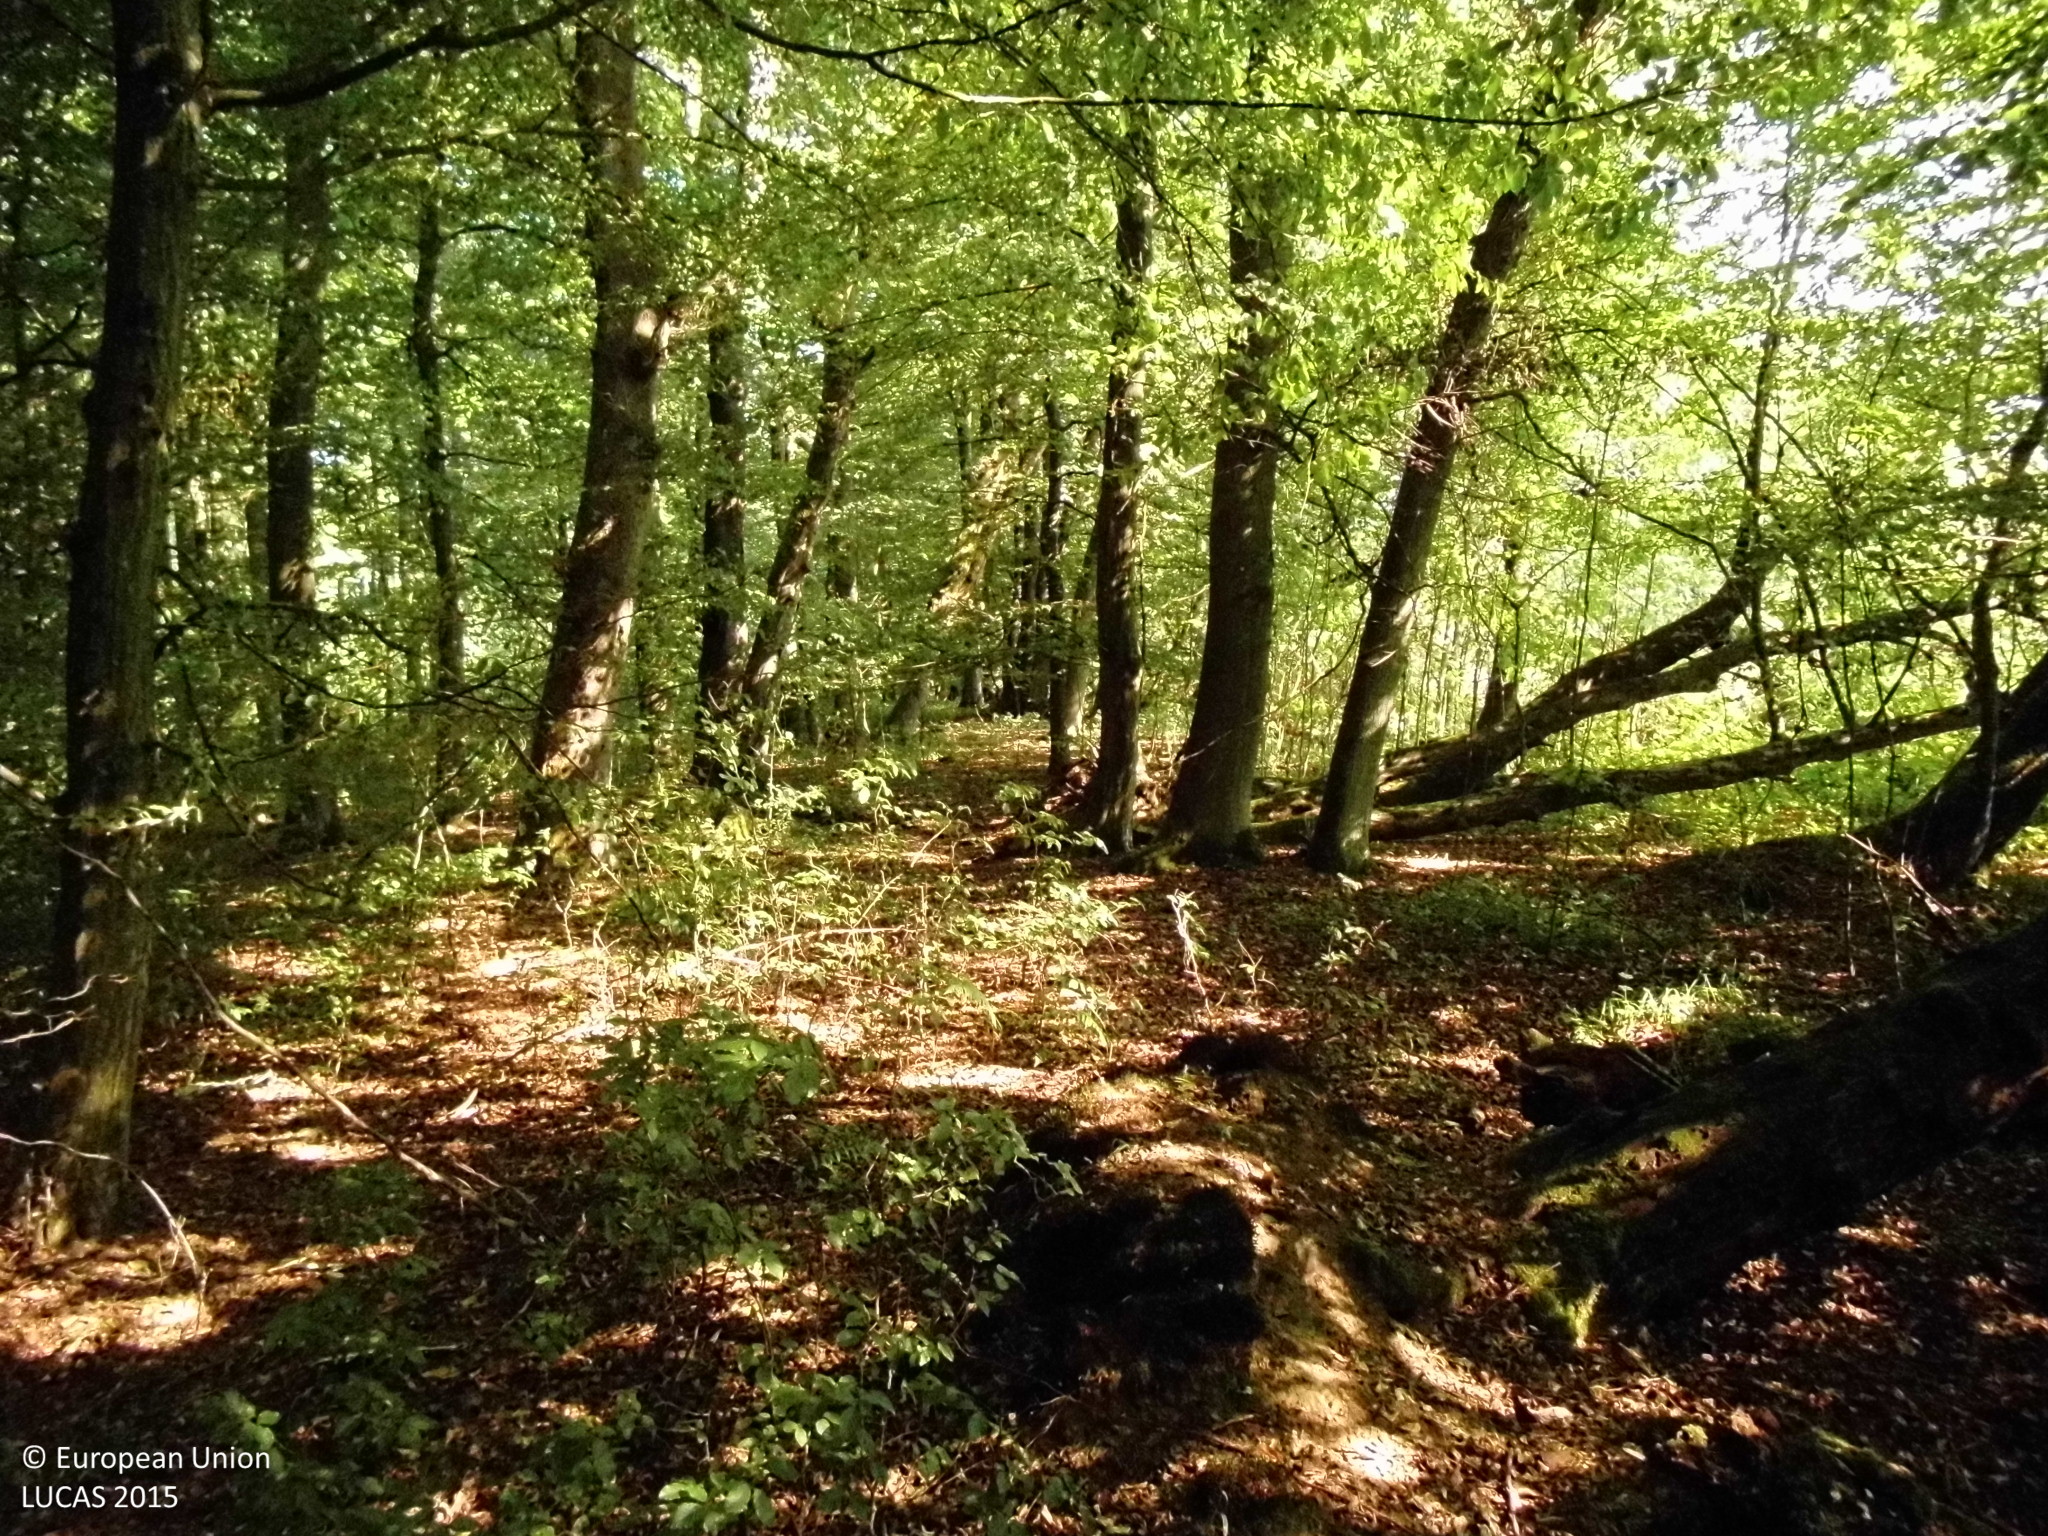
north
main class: Woodland
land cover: Broadleaved woodland
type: mesophytic deciduous forest
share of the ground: > 75 %
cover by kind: broadleaved forest trees 100 %
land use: Forestry
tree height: > 5 m
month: August
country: DE
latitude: 50.5985
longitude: 8.0083
